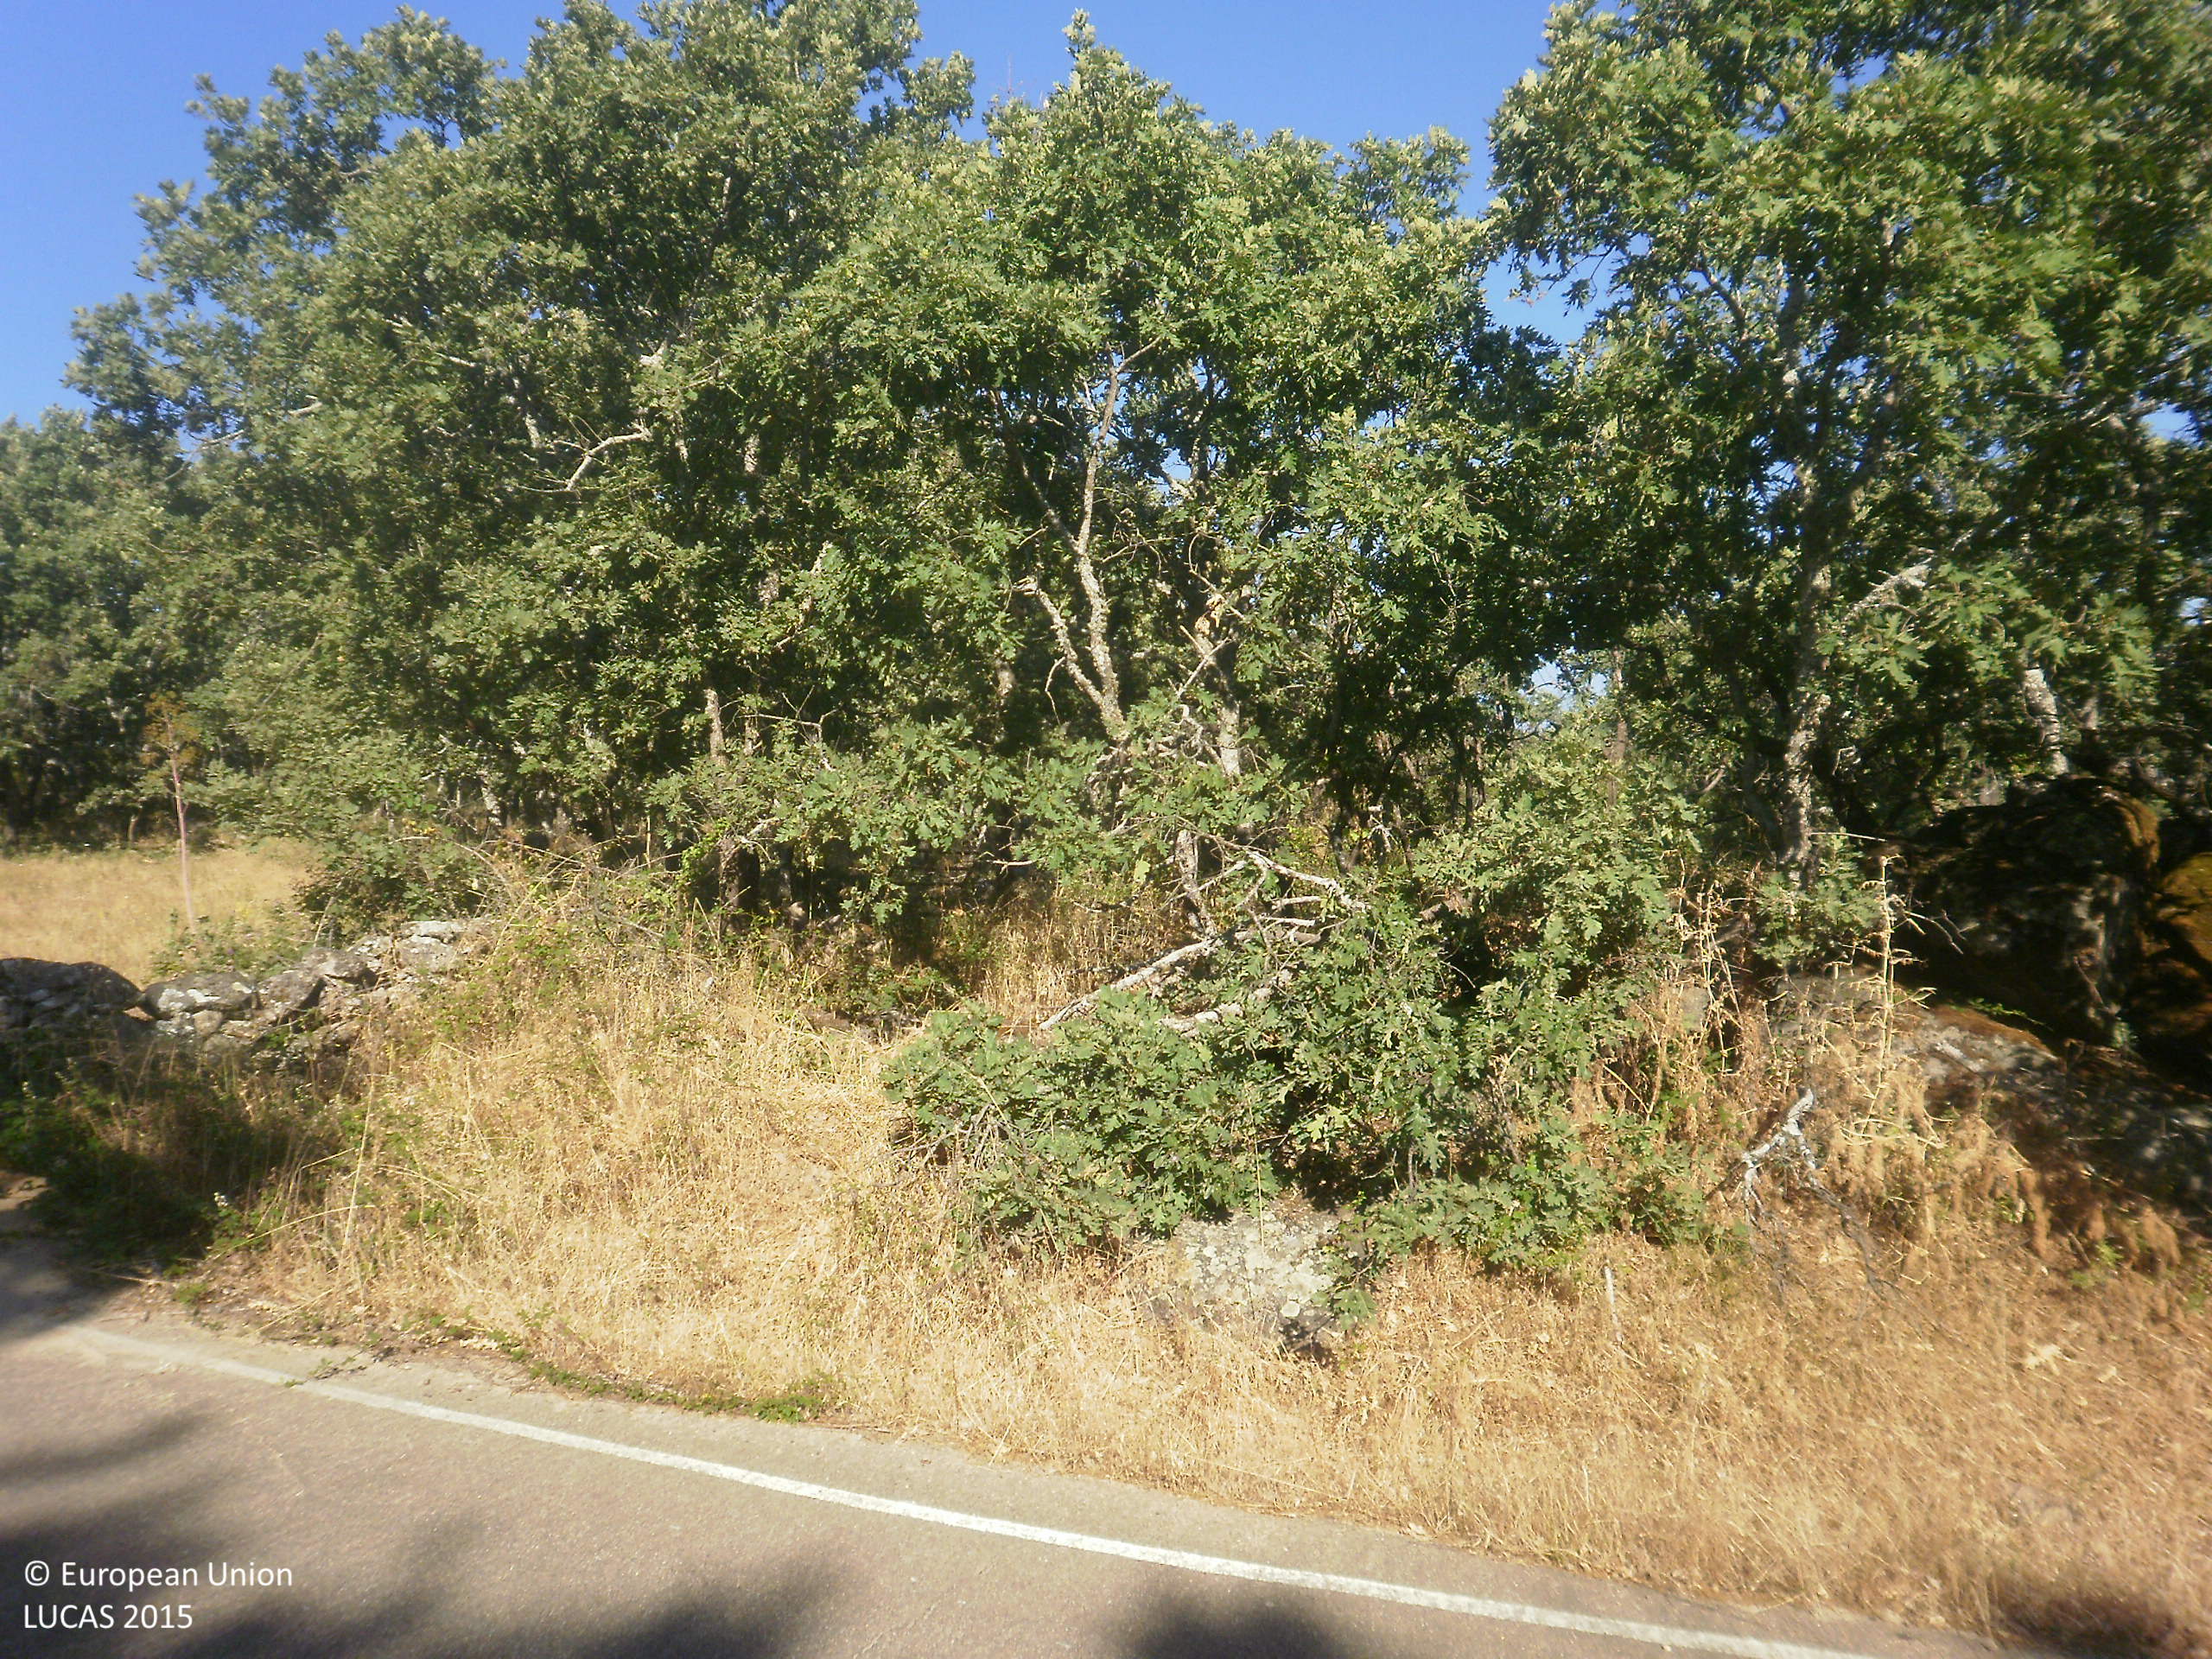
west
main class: Woodland
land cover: Broadleaved woodland
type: thermophilous deciduous forest
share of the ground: 50 - 75 %
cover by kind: broadleaved forest trees 60 %, herbaceous plants 40 %
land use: Forestry
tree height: > 5 m
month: June
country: ES
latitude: 39.2160
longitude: -6.0284
